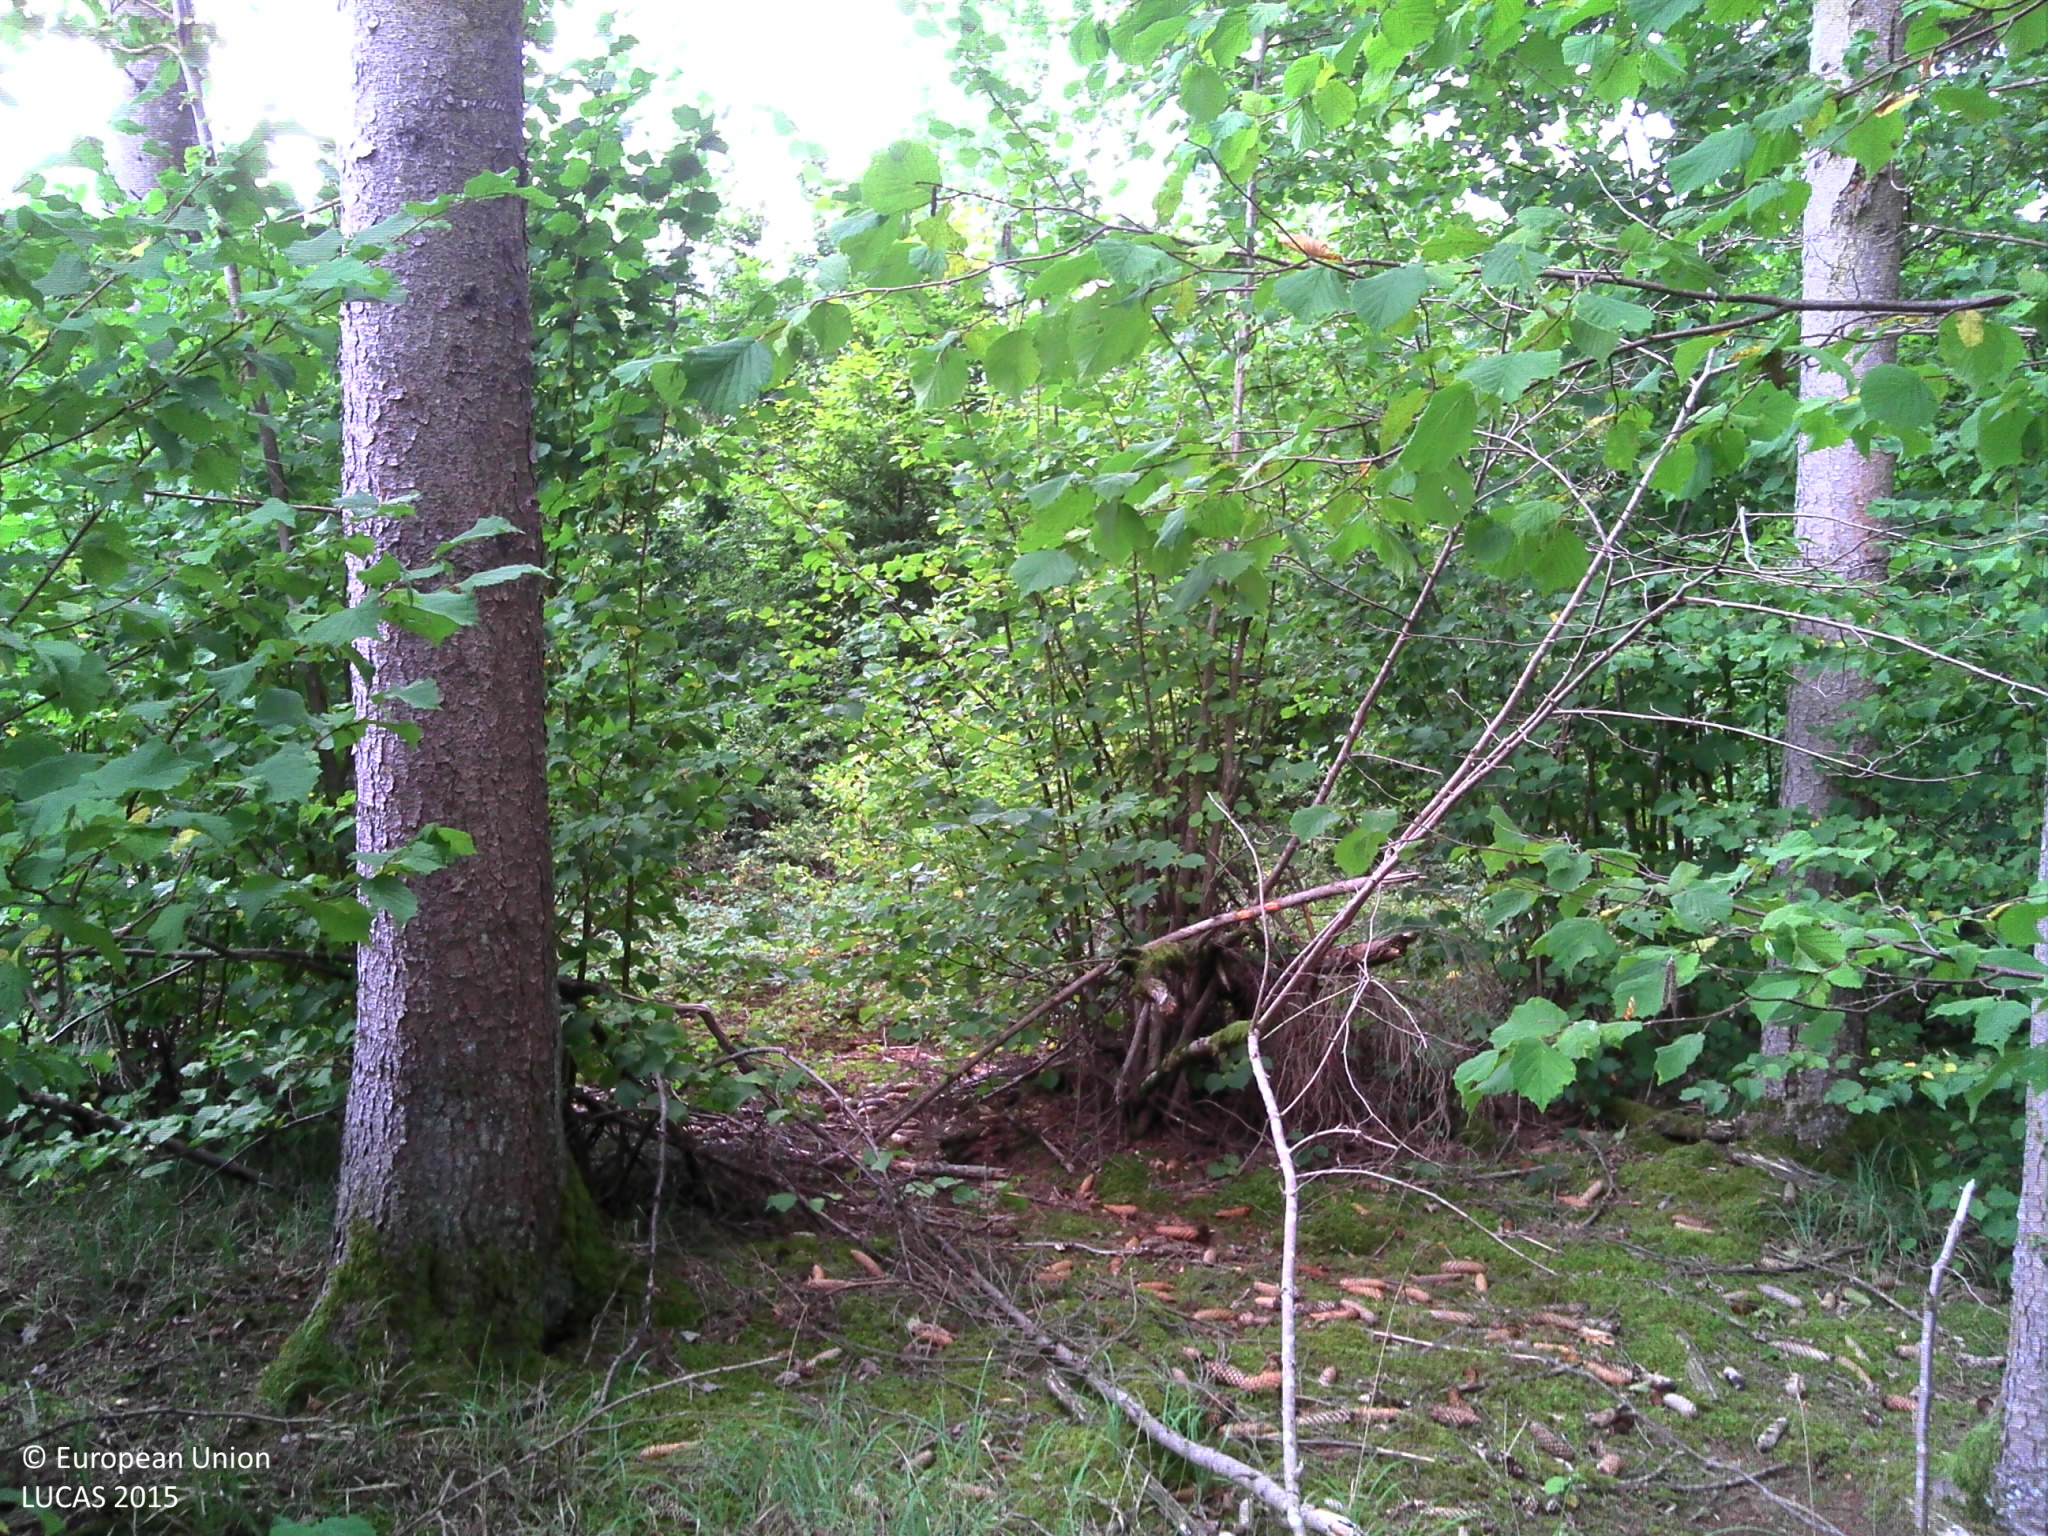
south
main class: Woodland
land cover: Spruce dominated mixed woodland
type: exotic forest
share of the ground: > 75 %
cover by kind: broadleaved forest trees 55 %, coniferous forest trees 30 %, herbaceous plants 10 %, lichens and mosses 5 %
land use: Forestry
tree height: > 5 m
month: August
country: FR
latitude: 47.7382
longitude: 4.7583
